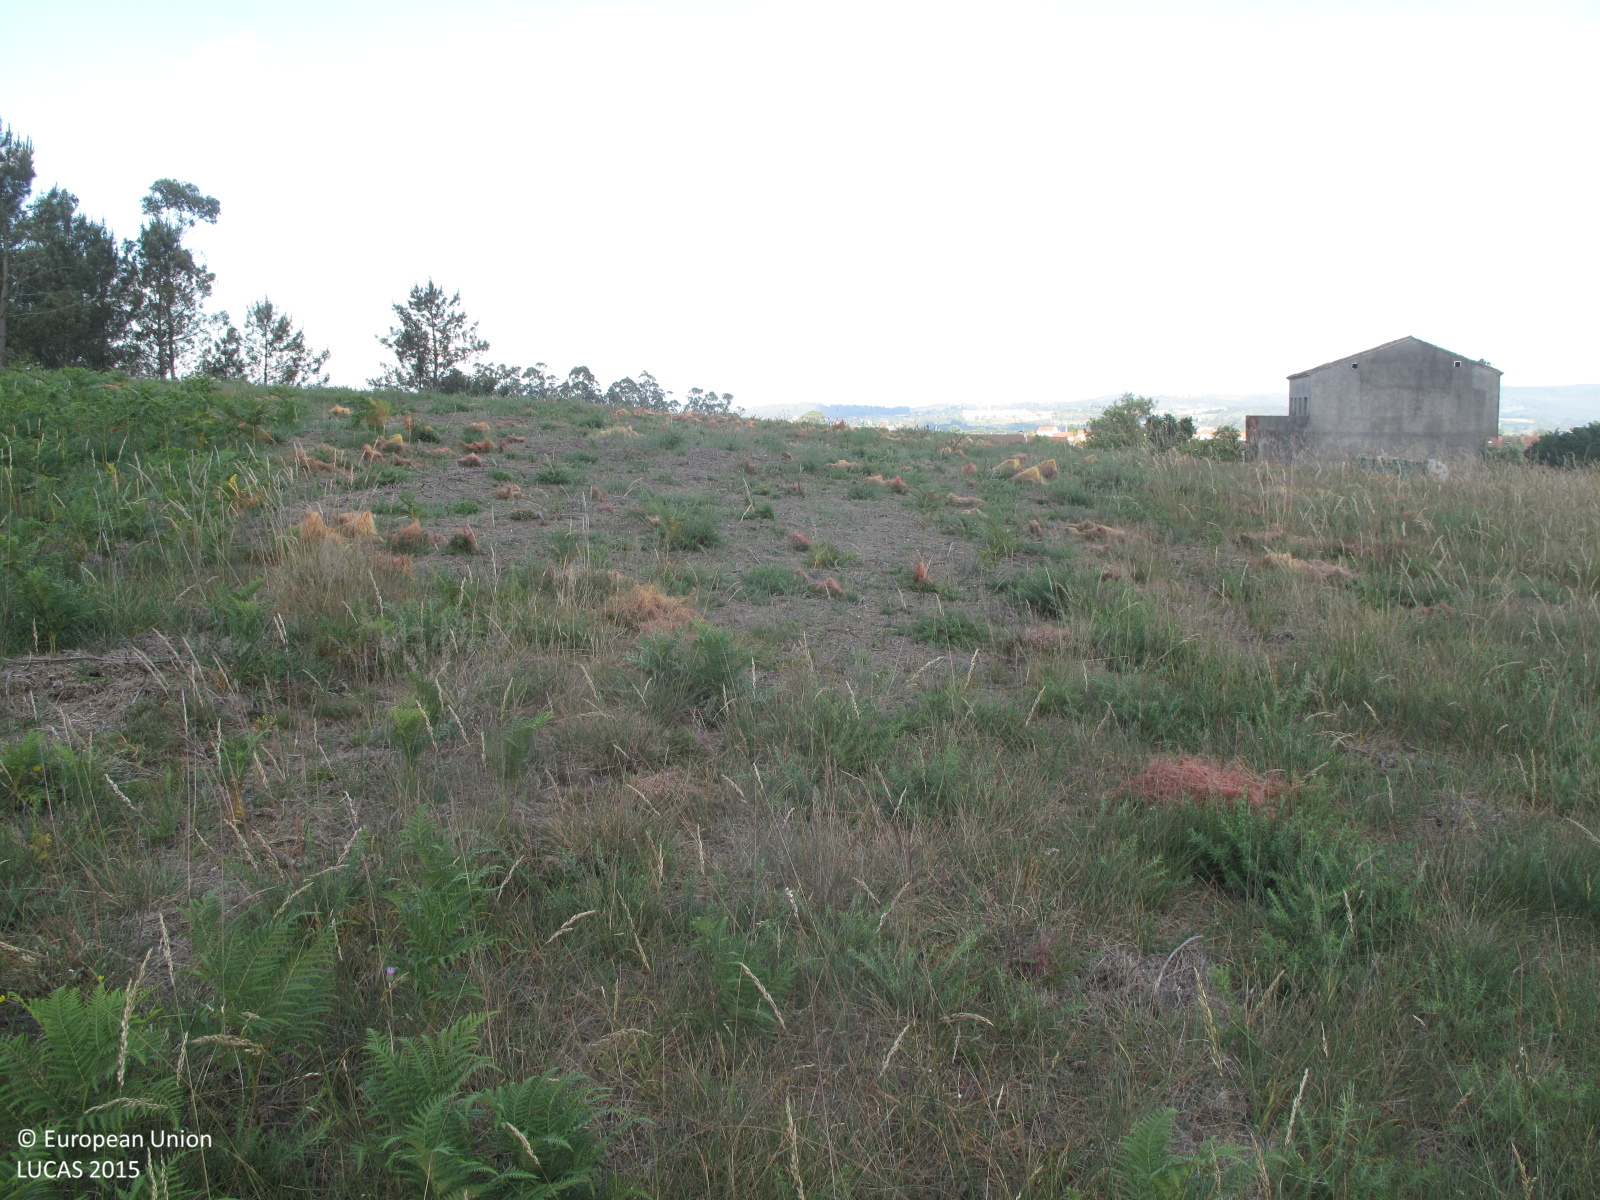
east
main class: Shrubland
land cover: Shrubland without tree cover
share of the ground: 10 - 25 %
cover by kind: herbaceous plants 90 %, shrubs 10 %
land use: Abandoned areas
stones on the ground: < 10 %
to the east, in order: Shrubland without tree cover; Temporary grasslands; Shrubland with sparse tree cover
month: June
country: ES
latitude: 42.9023
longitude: -8.5371
